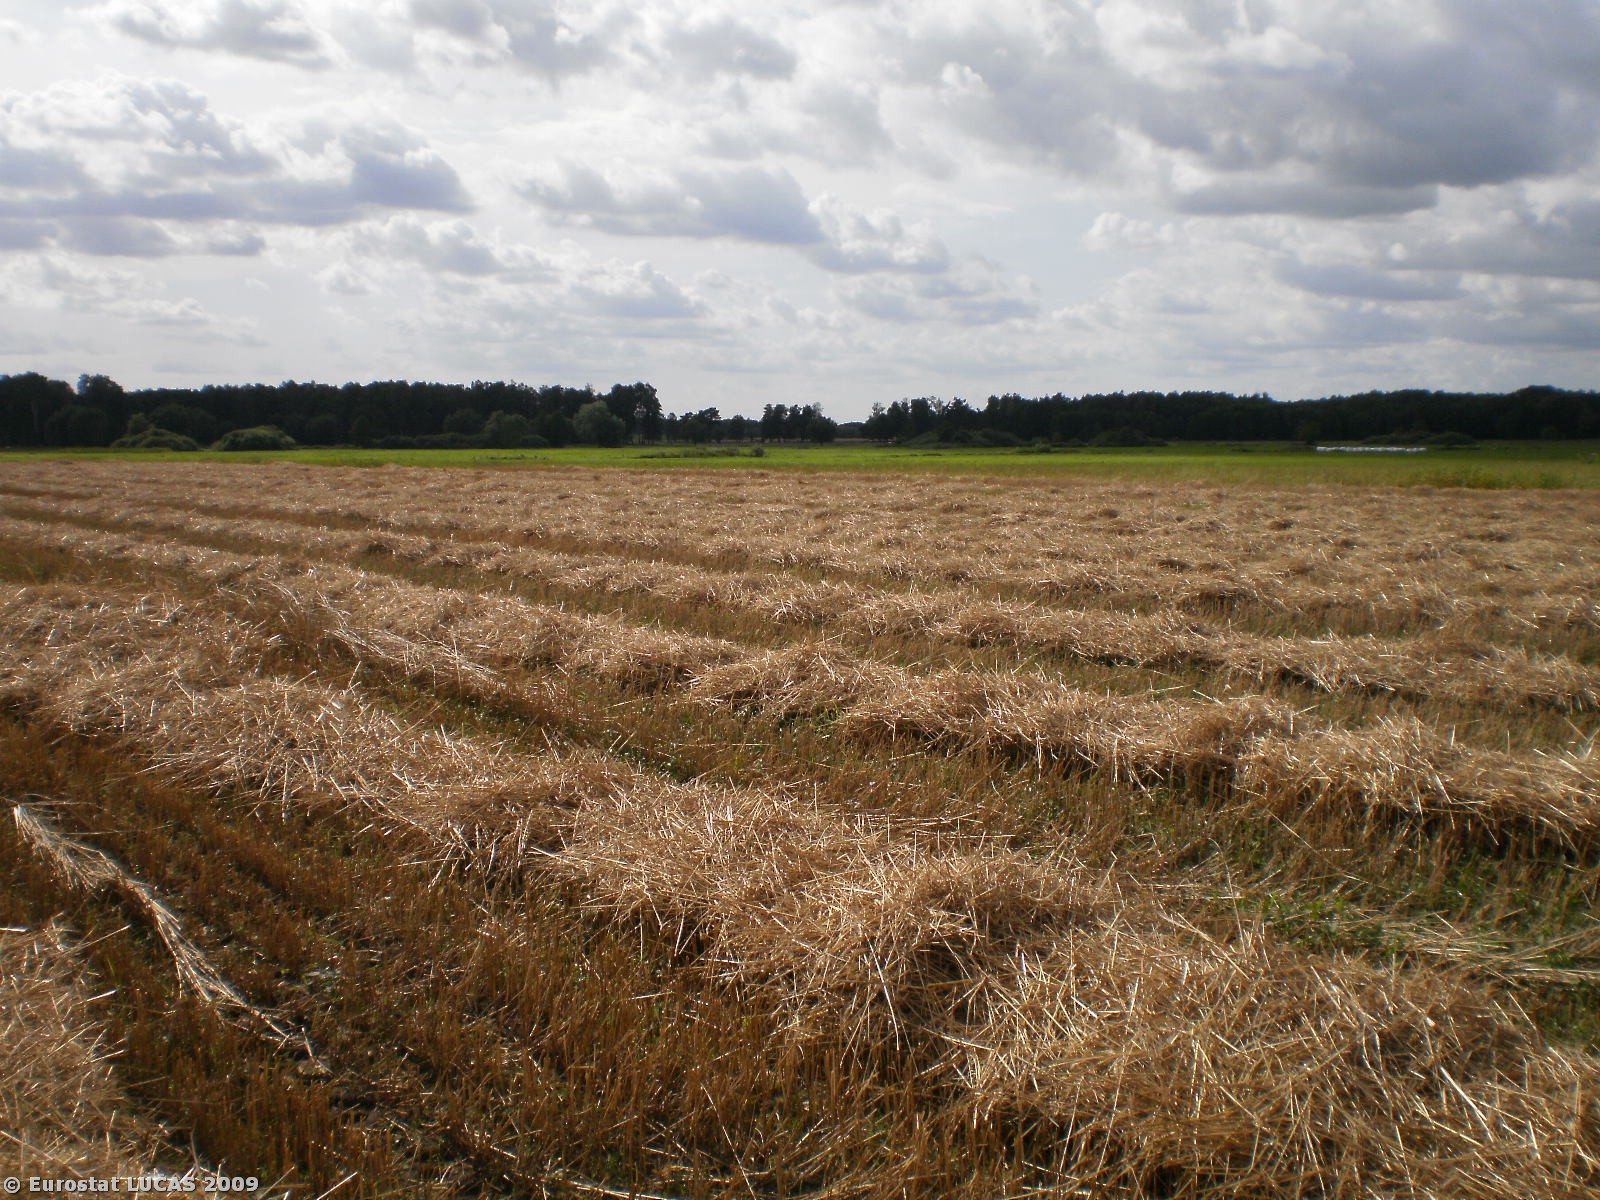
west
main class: Cropland
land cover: Rye
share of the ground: < 10 %
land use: Agriculture (excluding fallow land and kitchen gardens)
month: August
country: PL
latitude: 53.0916
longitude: 21.8369
